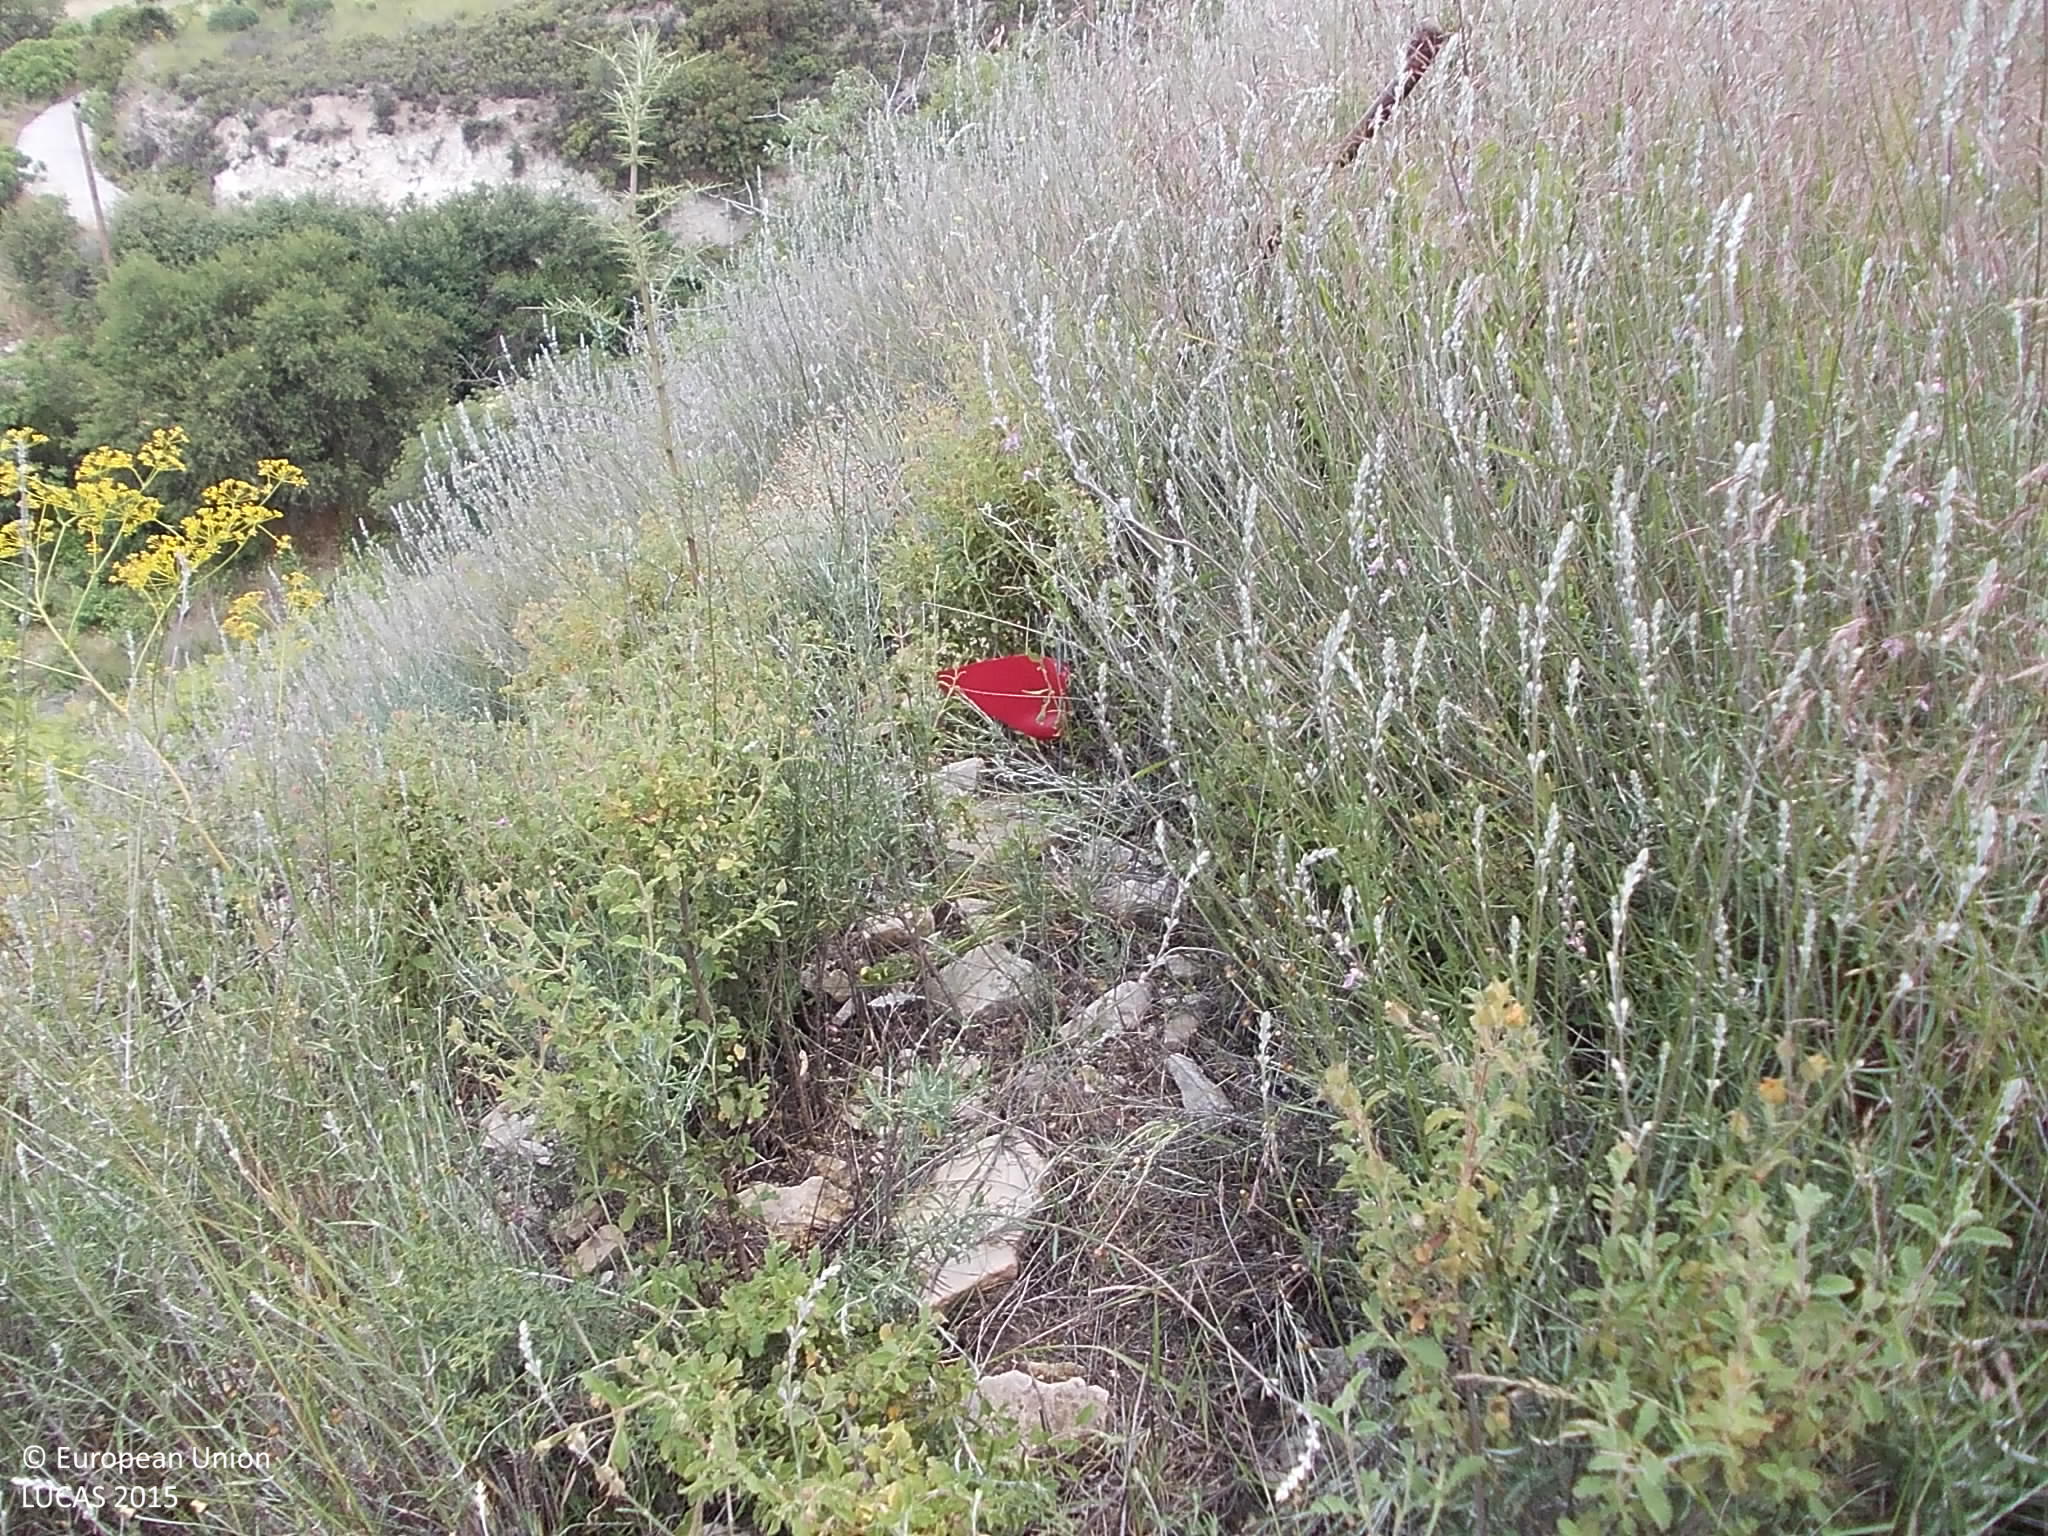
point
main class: Shrubland
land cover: Shrubland without tree cover
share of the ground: 10 - 25 %
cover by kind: herbaceous plants 75 %, shrubs 25 %
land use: Semi-natural and natural areas not in use
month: May
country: CY
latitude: 34.8425
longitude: 32.8094
